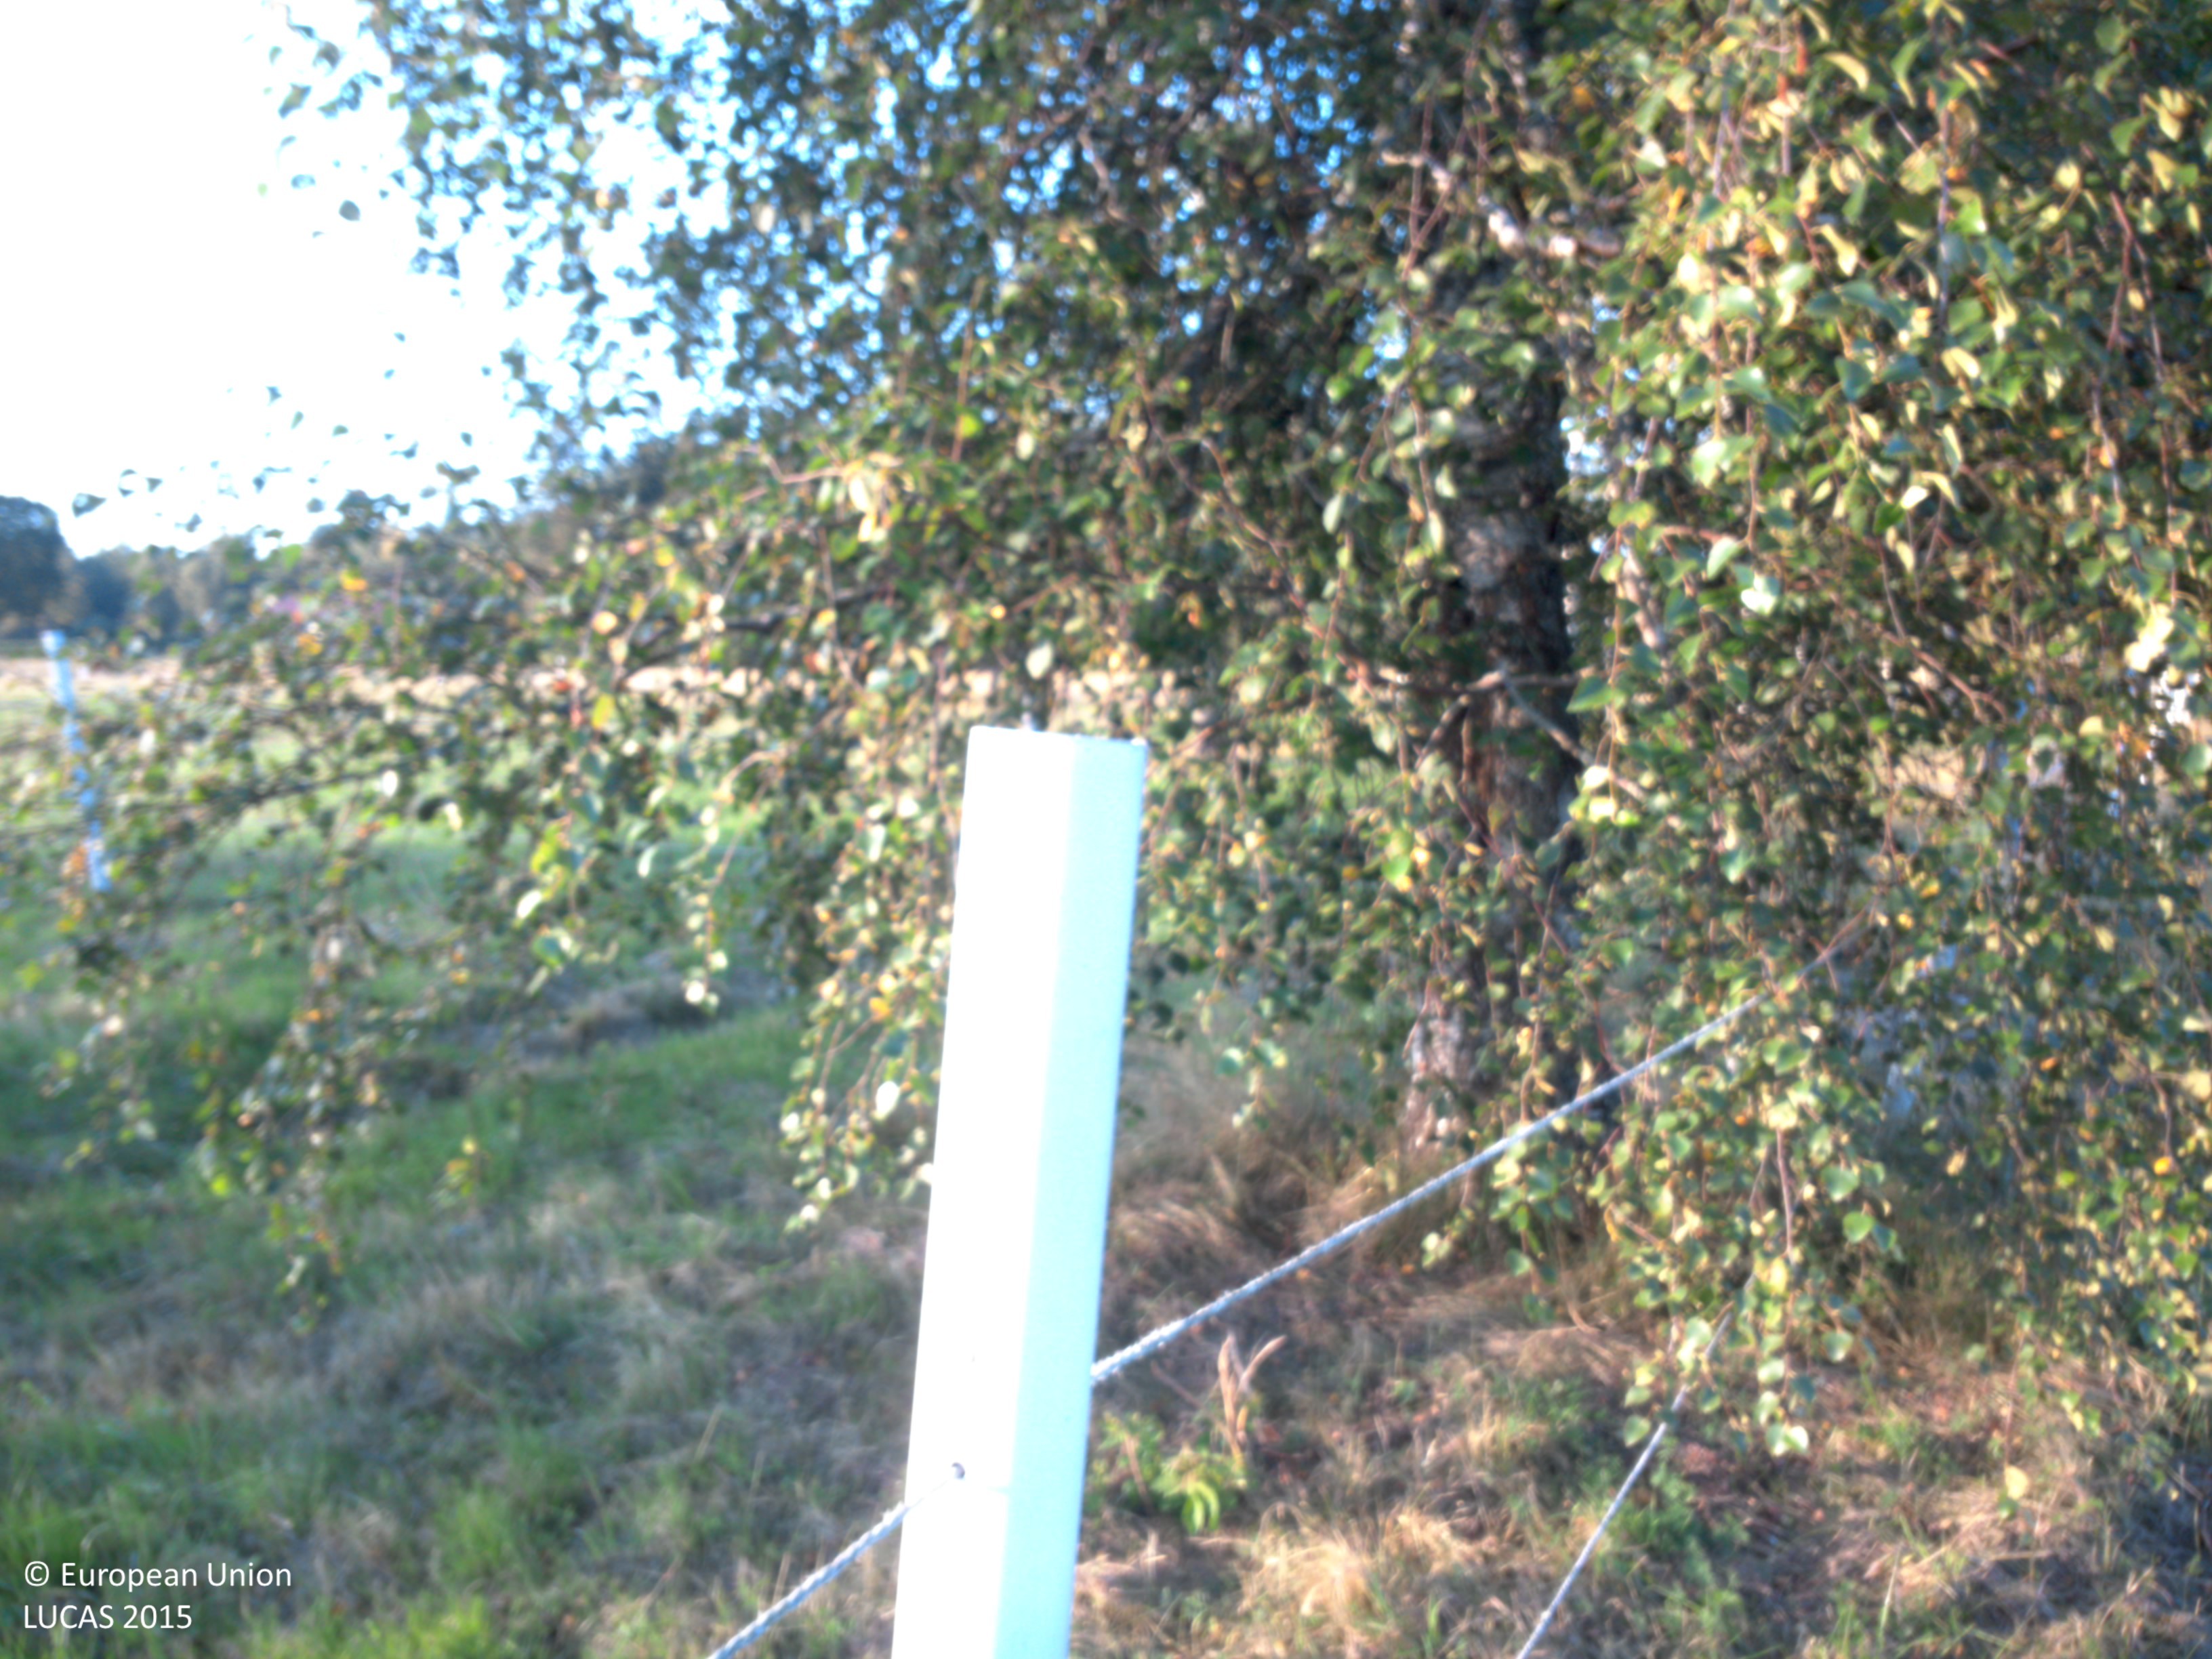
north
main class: Grassland
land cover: Grassland without tree/shrub cover
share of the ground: > 75 %
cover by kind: herbaceous plants 100 %
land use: Agriculture (excluding fallow land and kitchen gardens)
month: August
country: SE
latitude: 58.4707
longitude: 12.2415
